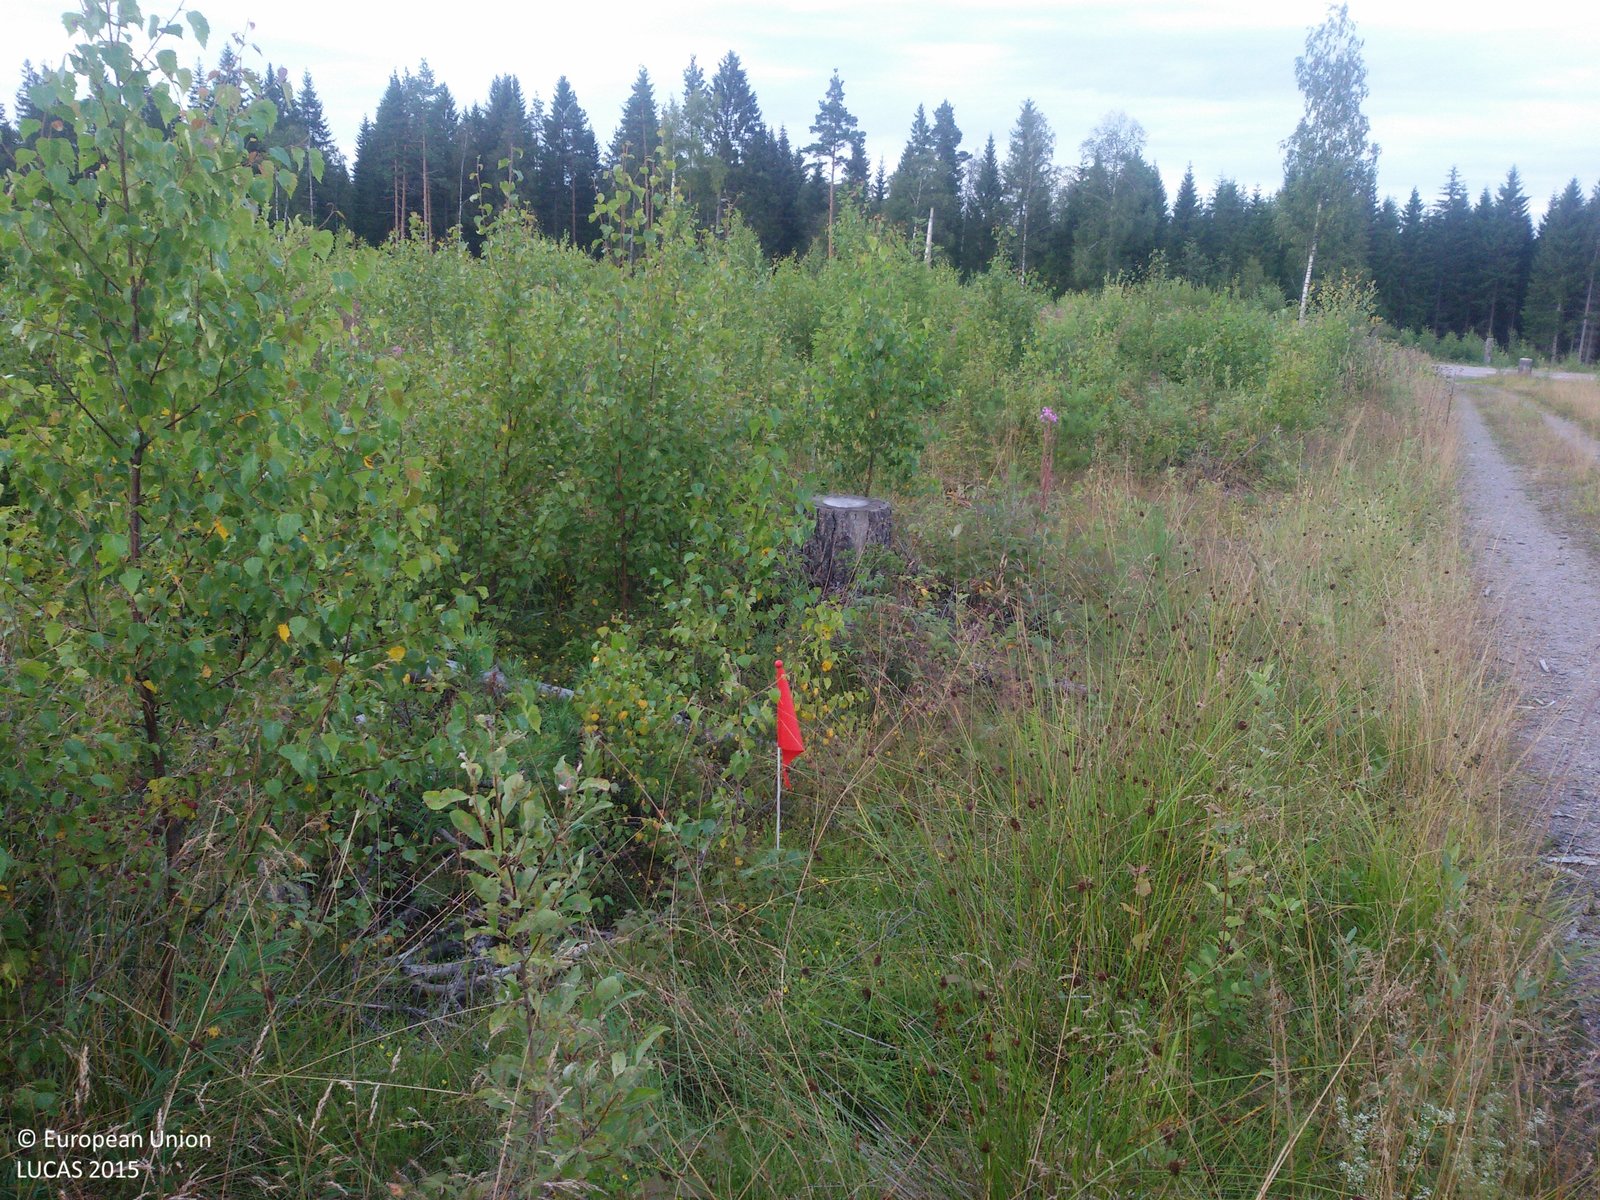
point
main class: Woodland
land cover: Broadleaved woodland
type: boreal forest
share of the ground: > 75 %
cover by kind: broadleaved forest trees 60 %, herbaceous plants 20 %, coniferous forest trees 15 %, shrubs 5 %
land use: Forestry
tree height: < 5 m
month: August
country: SE
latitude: 60.4996
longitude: 16.5243
